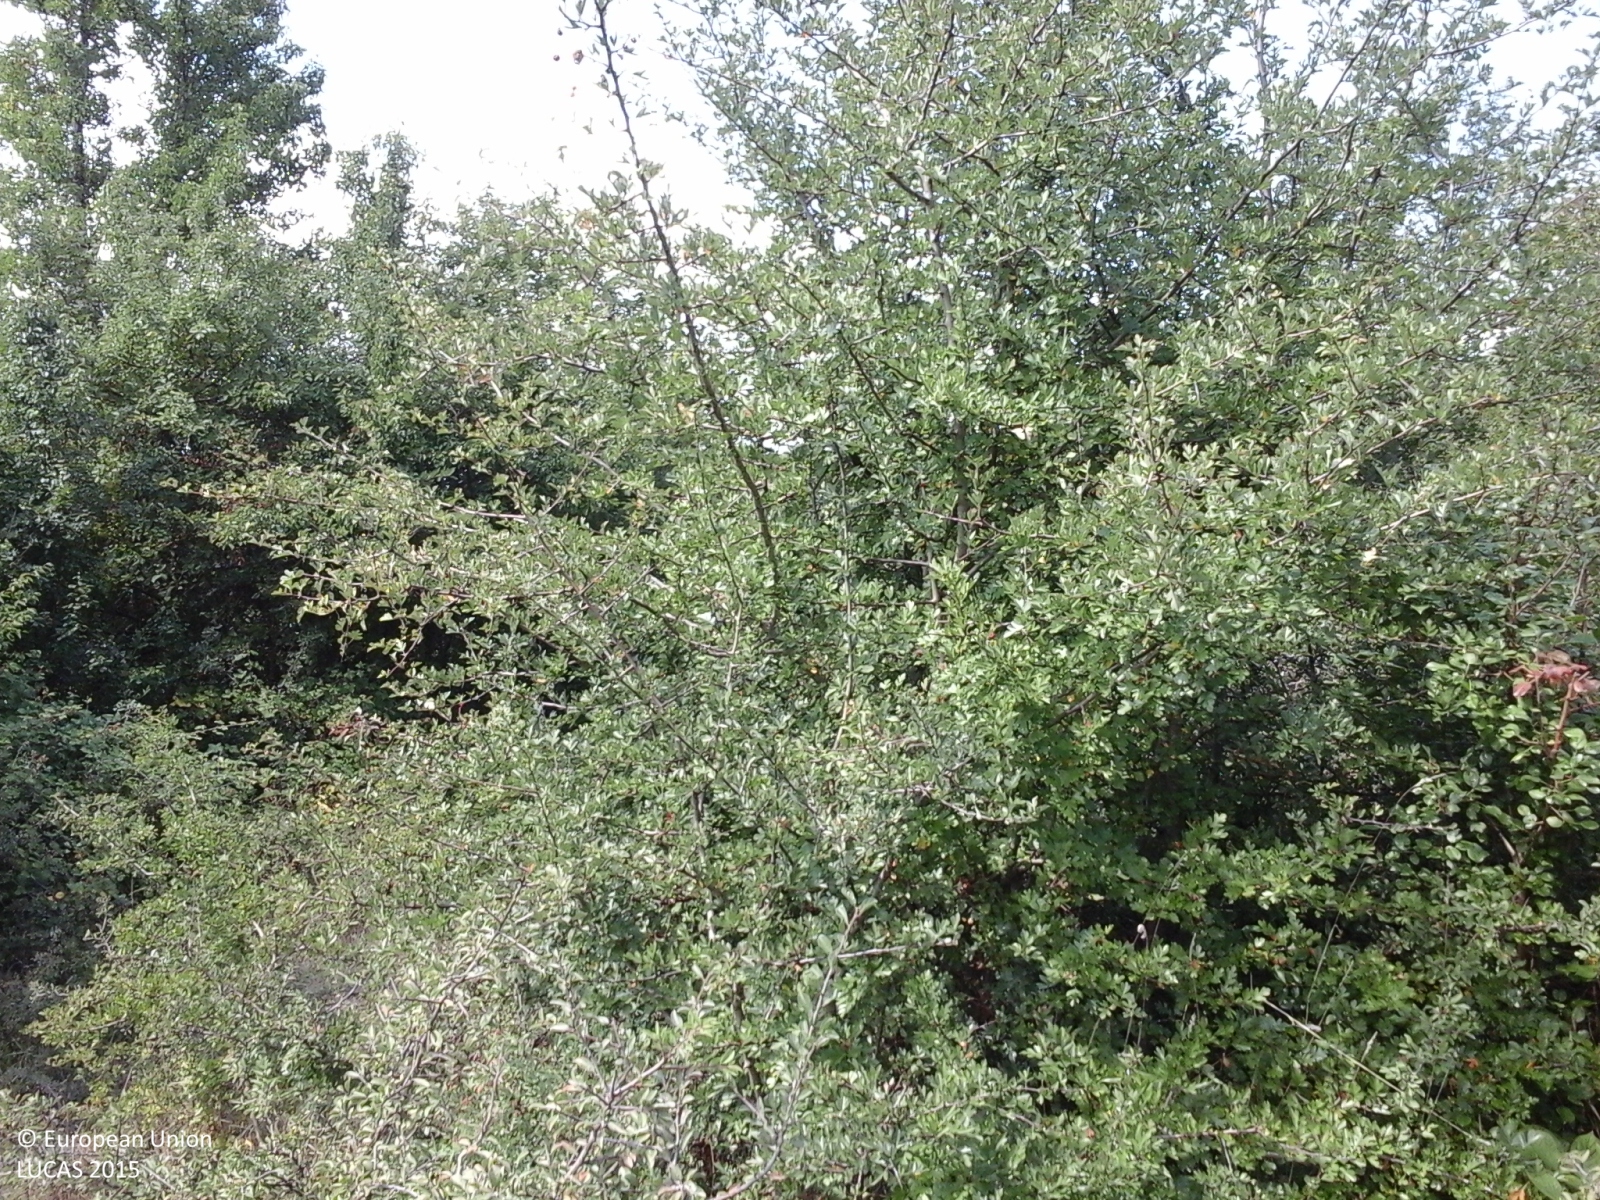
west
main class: Shrubland
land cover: Shrubland with sparse tree cover
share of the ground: > 75 %
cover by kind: herbaceous plants 50 %, shrubs 45 %, broadleaved forest trees 5 %
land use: Agriculture (excluding fallow land and kitchen gardens)
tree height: < 5 m
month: August
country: IT
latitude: 41.7666
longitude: 14.3036
